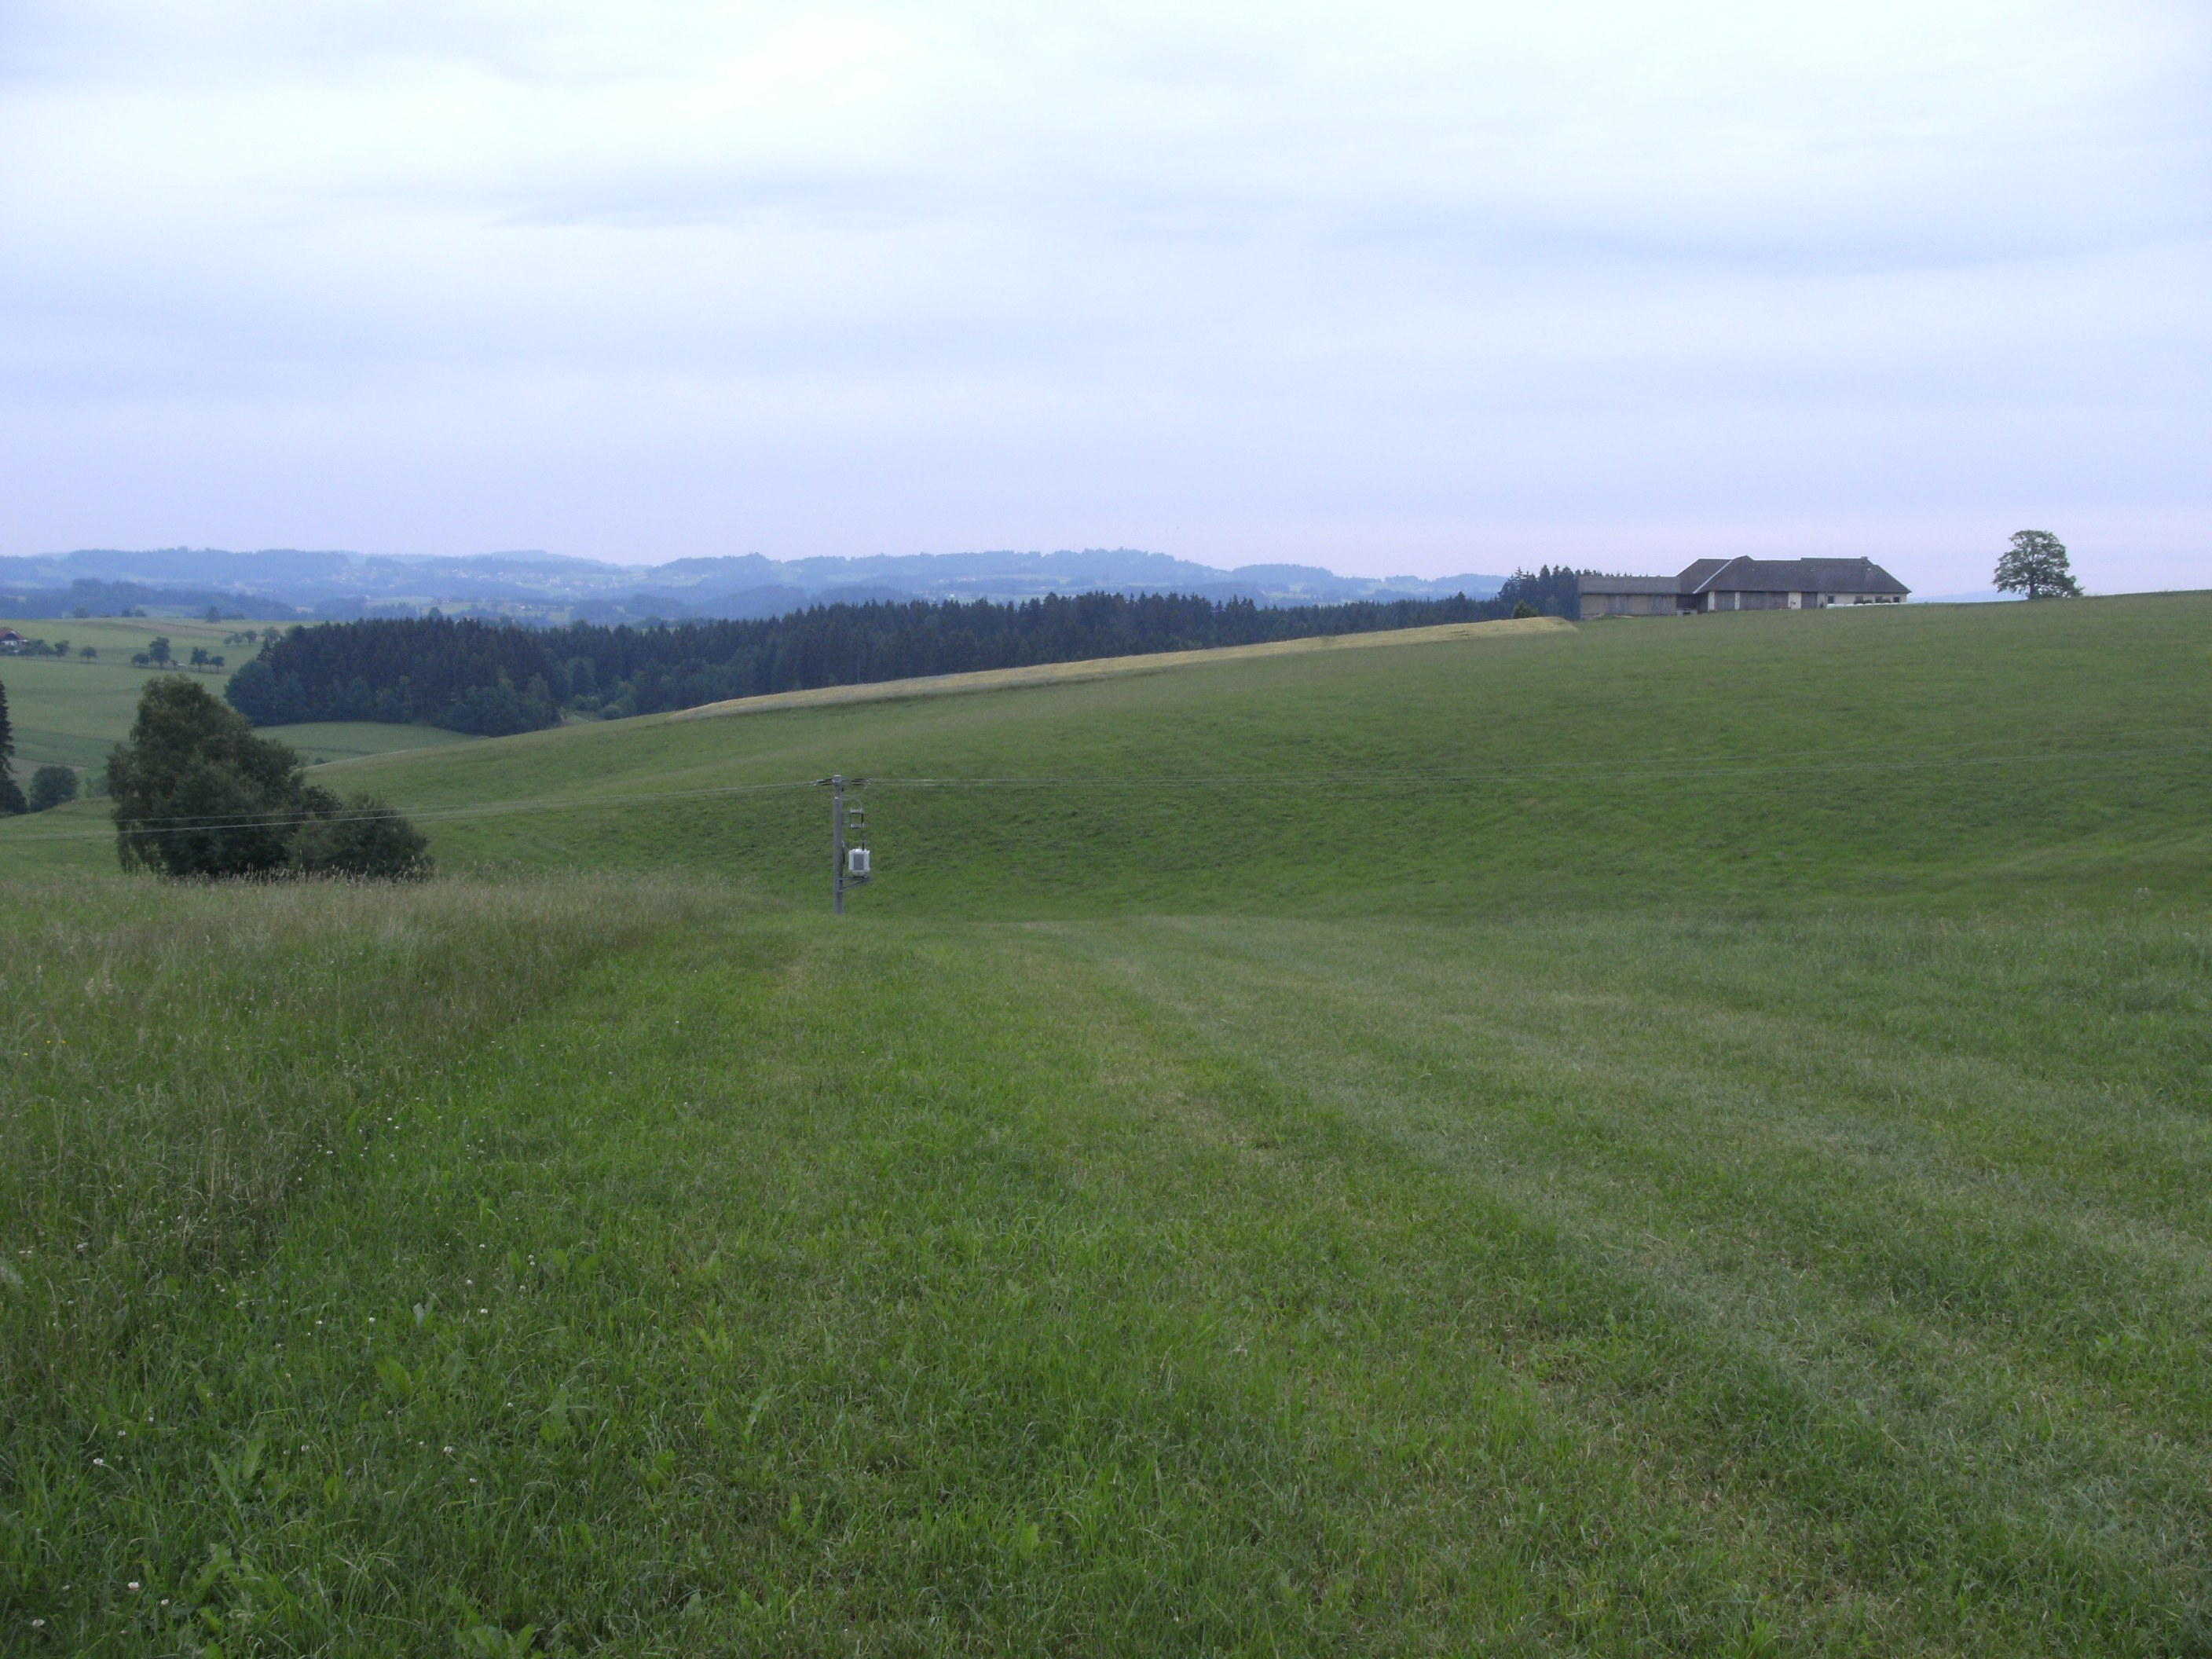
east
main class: Grassland
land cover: Grassland without tree/shrub cover
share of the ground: > 75 %
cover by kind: herbaceous plants 100 %
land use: Agriculture (excluding fallow land and kitchen gardens)
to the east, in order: Grassland without tree/shrub cover; Electric lines; Grassland without tree/shrub cover
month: June
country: AT
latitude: 48.4737
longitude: 14.0445
